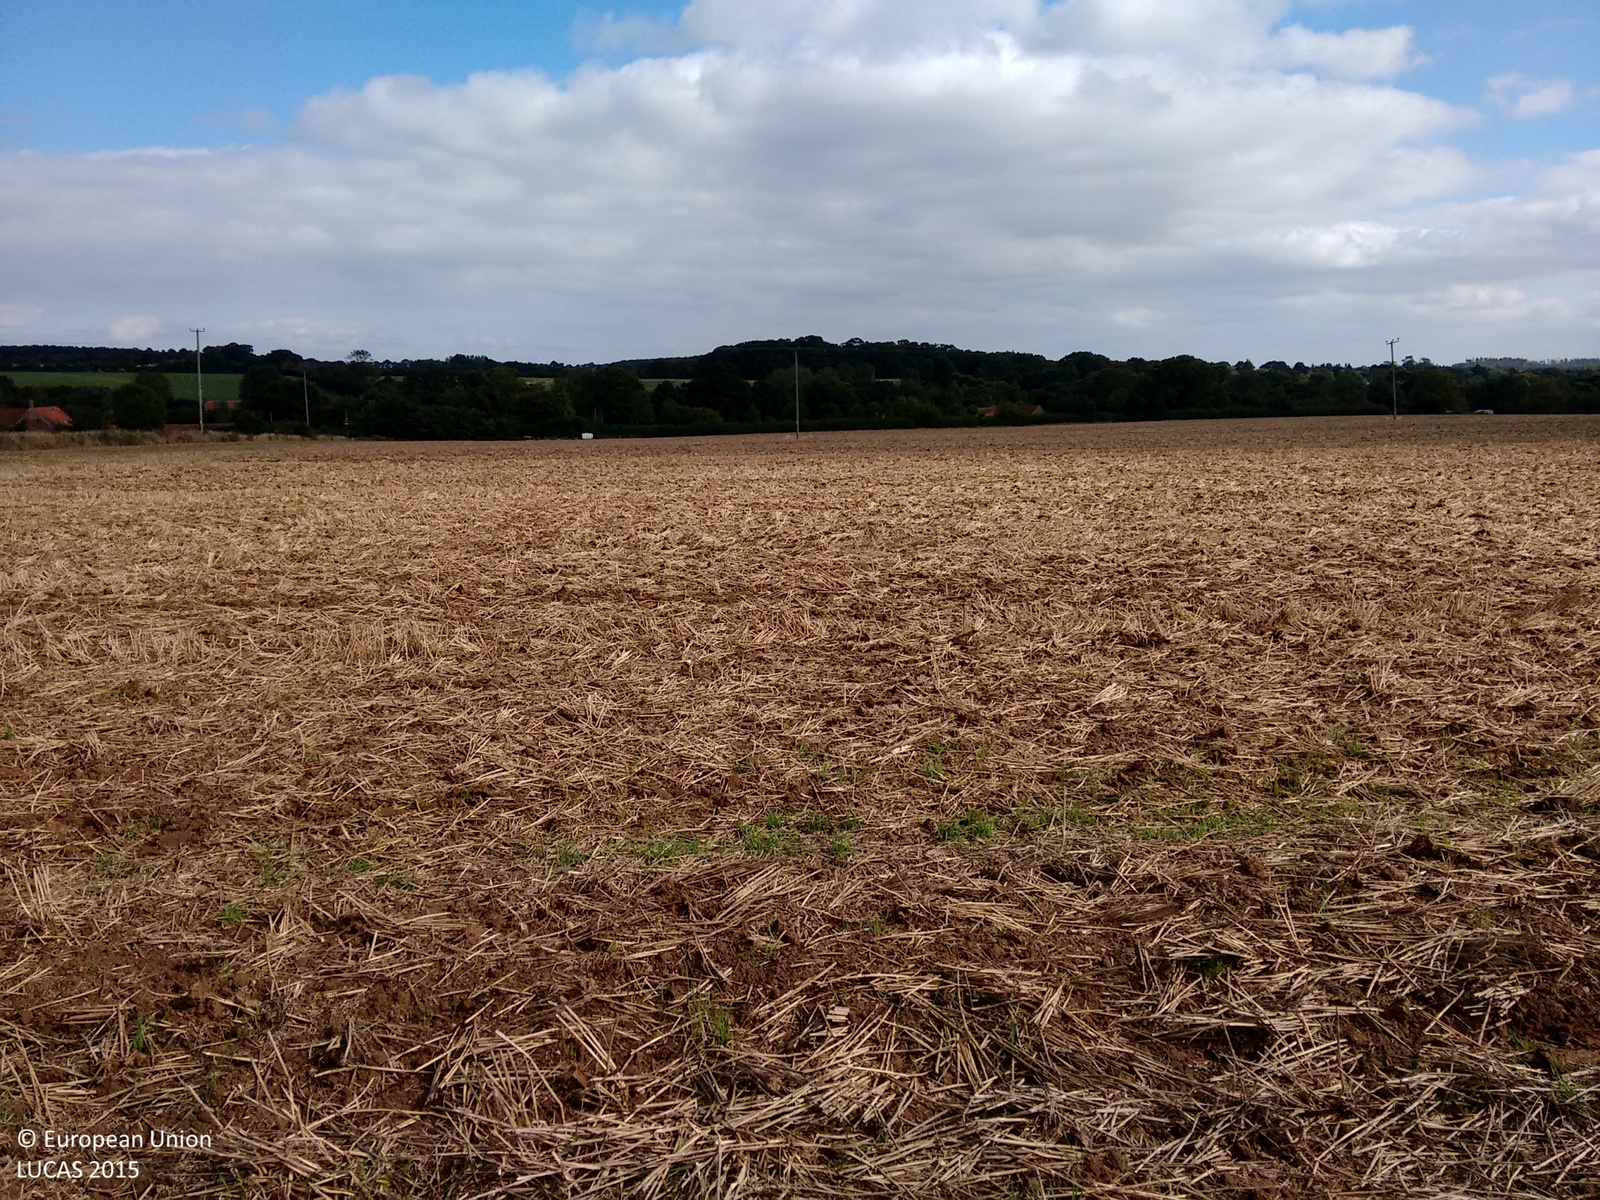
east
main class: Cropland
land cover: Common wheat
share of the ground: > 75 %
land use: Agriculture (excluding fallow land and kitchen gardens)
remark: Harvested field
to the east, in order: Common wheat; Electric lines; Common wheat
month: September
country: GB
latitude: 52.8884
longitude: 1.2851
